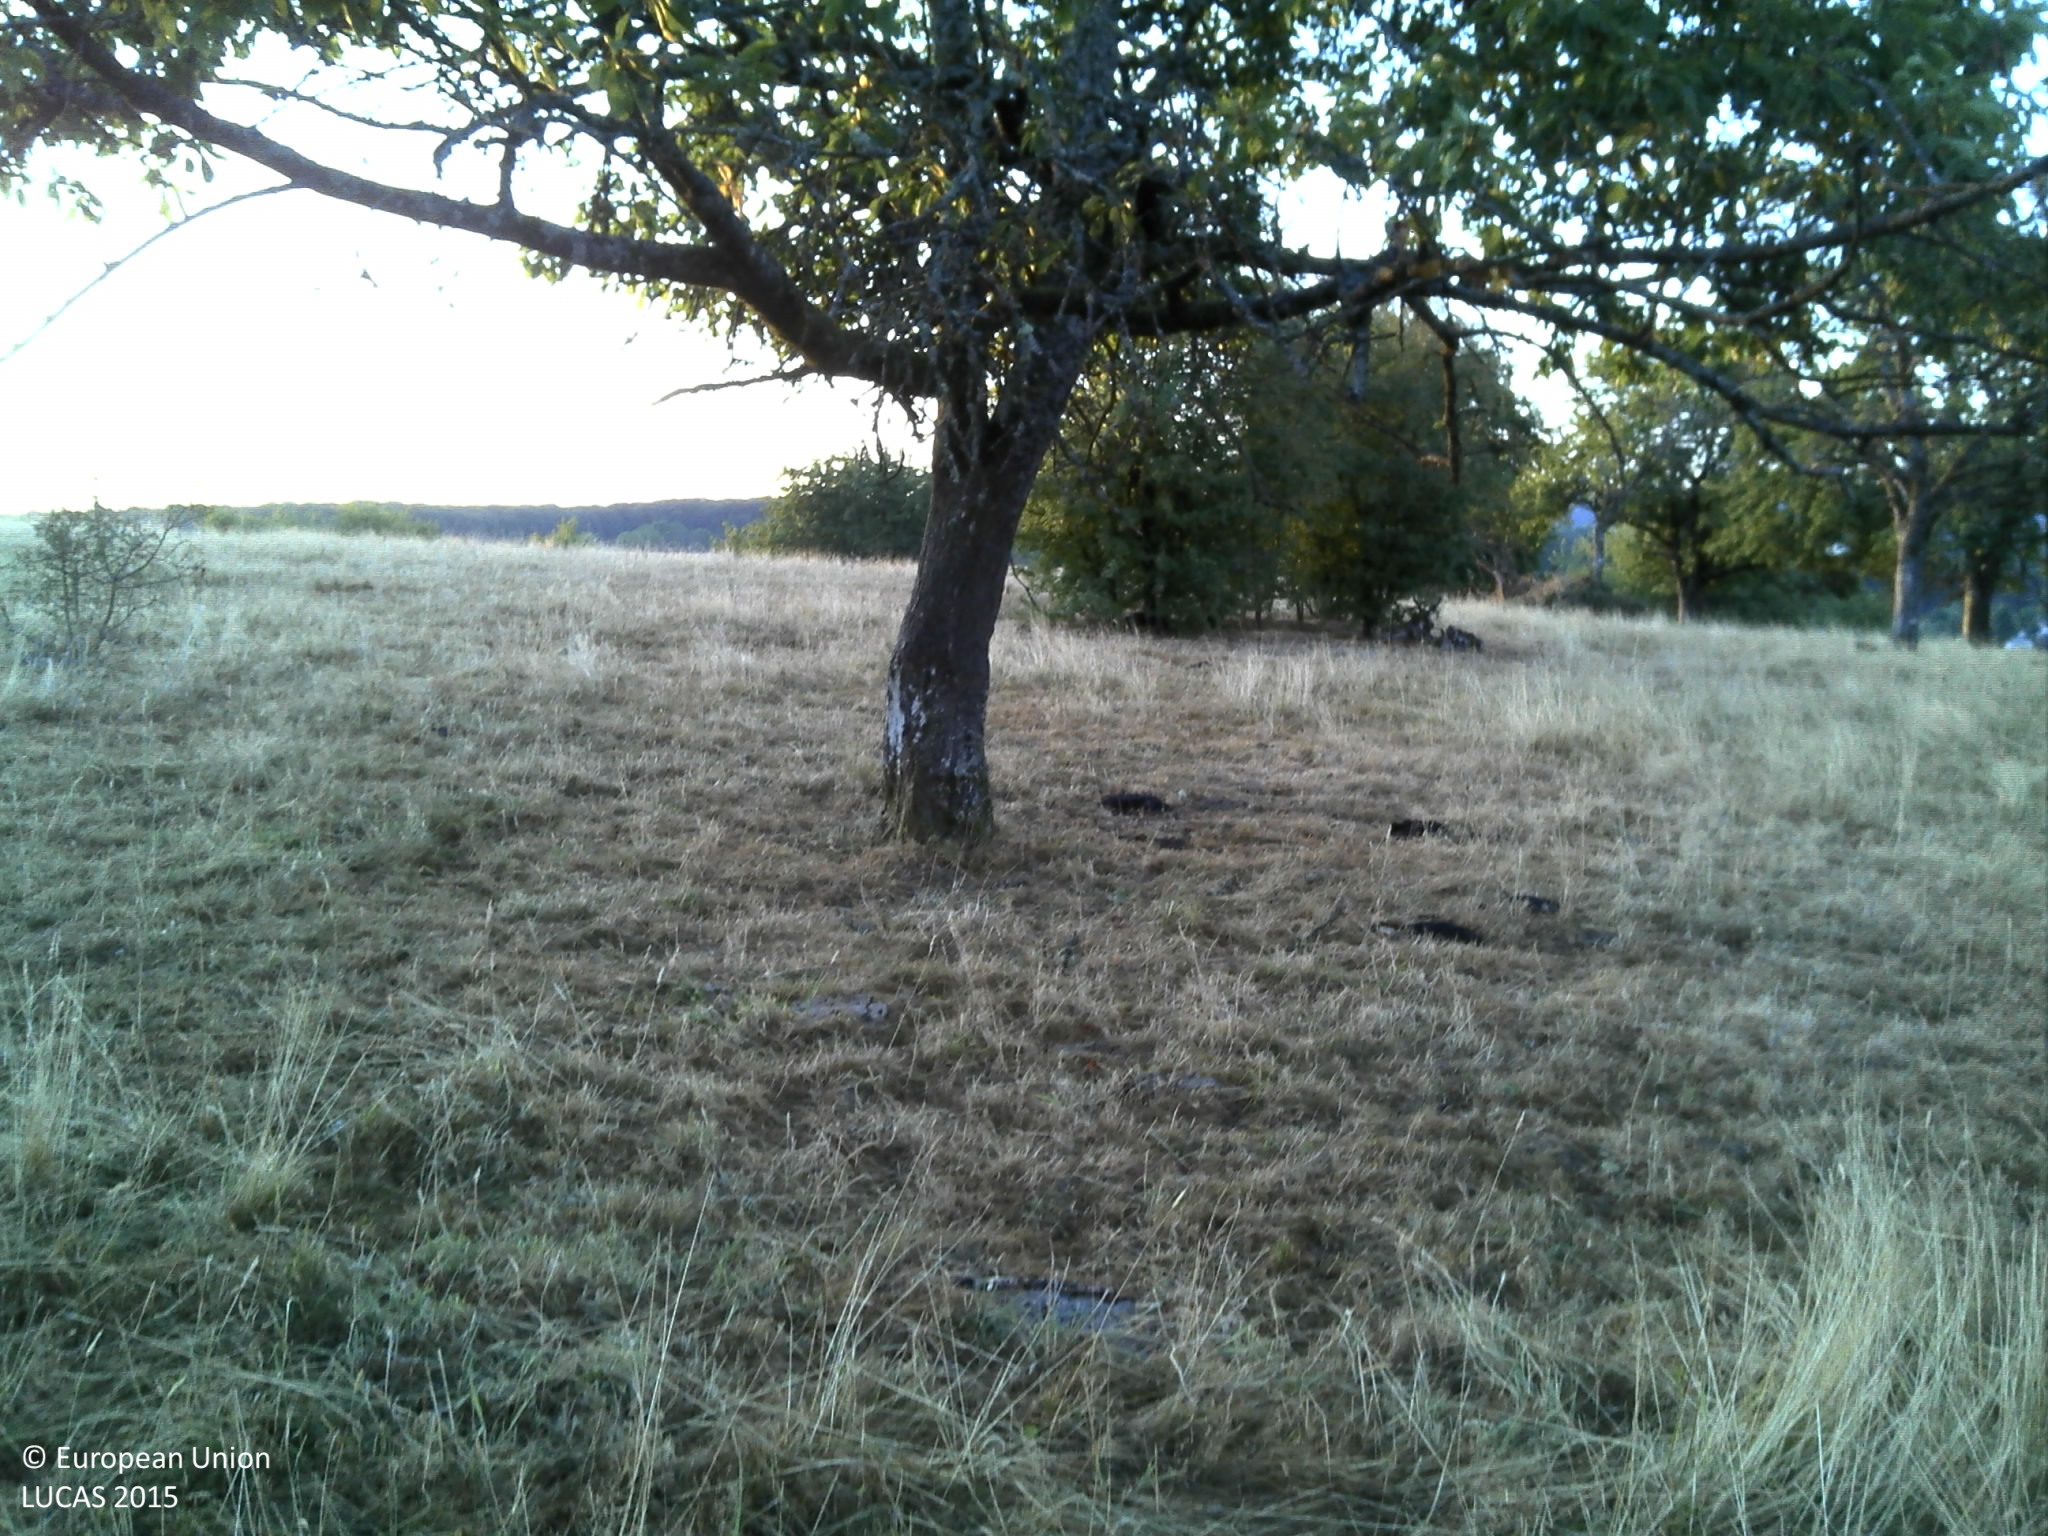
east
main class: Cropland
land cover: Cherry fruit
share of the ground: 10 - 25 %
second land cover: Grassland without tree/shrub cover
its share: > 75 %
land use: Agriculture (excluding fallow land and kitchen gardens)
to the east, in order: Cherry fruit; Grassland without tree/shrub cover; Grassland with sparse tree/shrub cover; Fences; Grassland without tree/shrub cover; Fences; Other bare soil
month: July
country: FR
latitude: 48.0349
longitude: 6.2858
